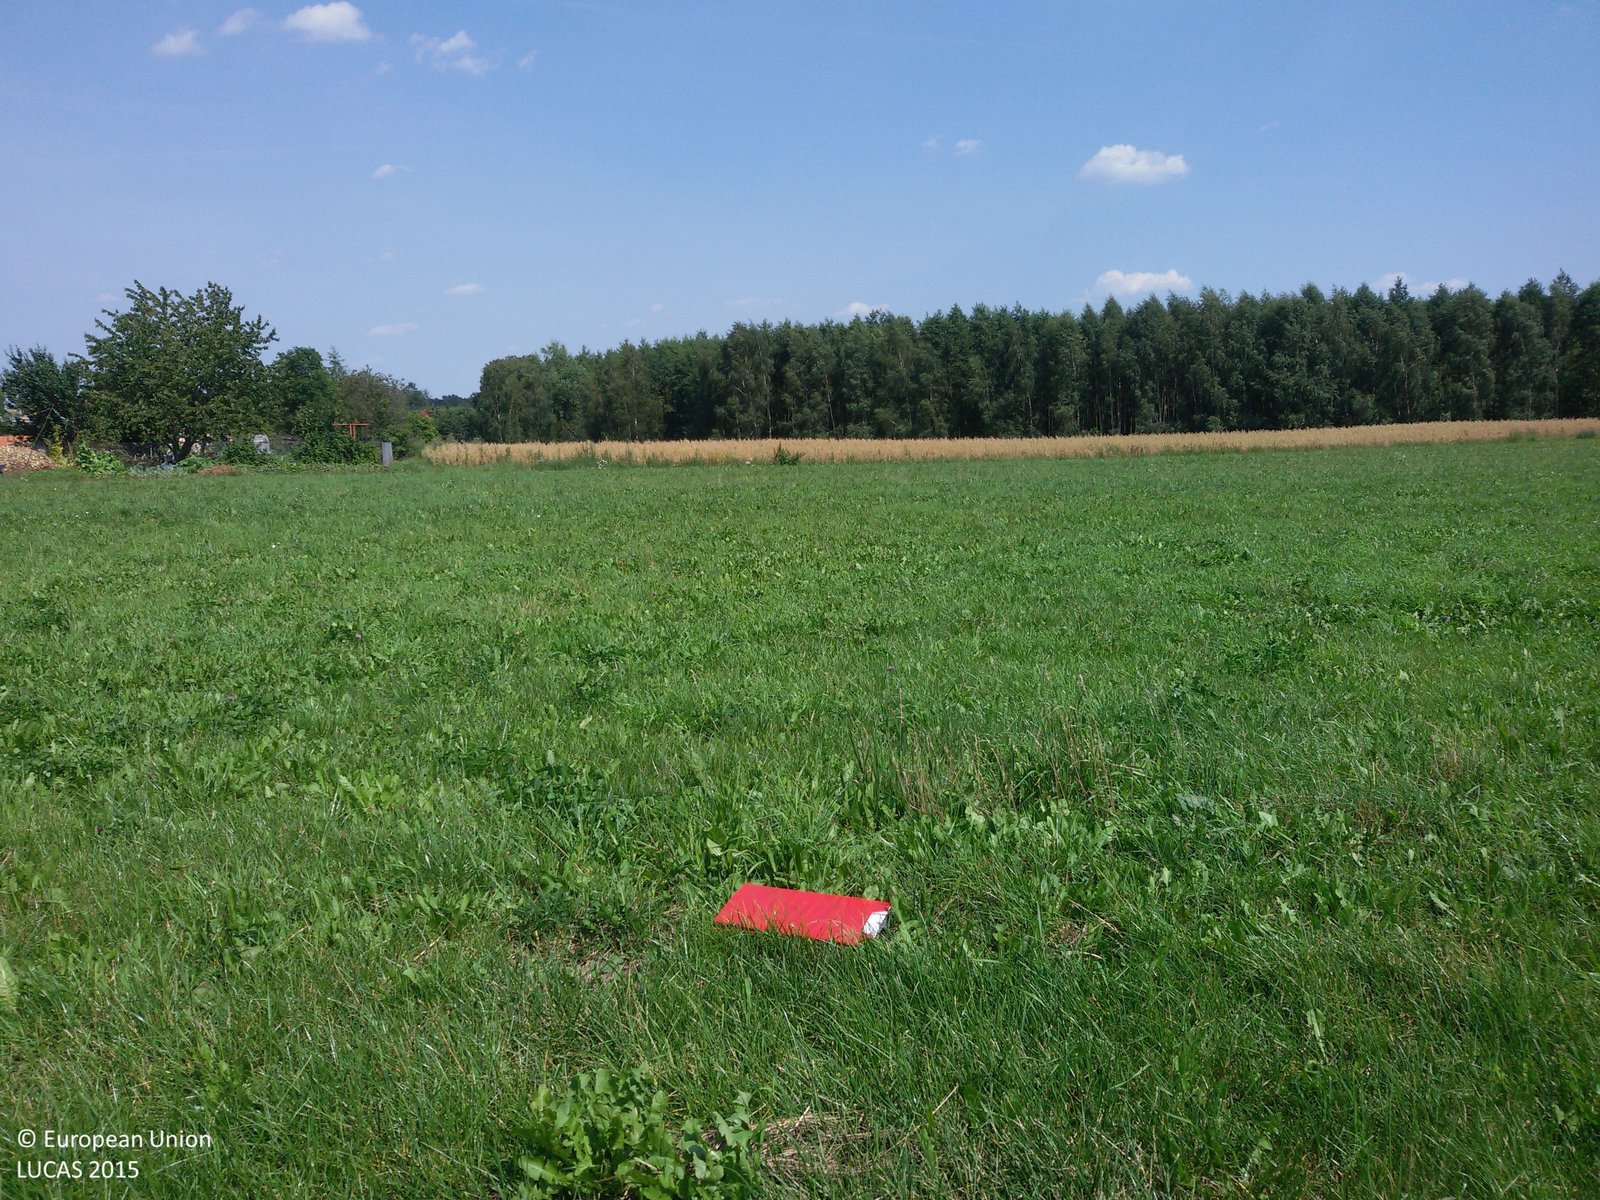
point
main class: Grassland
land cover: Grassland without tree/shrub cover
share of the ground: > 75 %
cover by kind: herbaceous plants 100 %
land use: Agriculture (excluding fallow land and kitchen gardens)
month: August
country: PL
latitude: 53.5701
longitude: 17.7293
